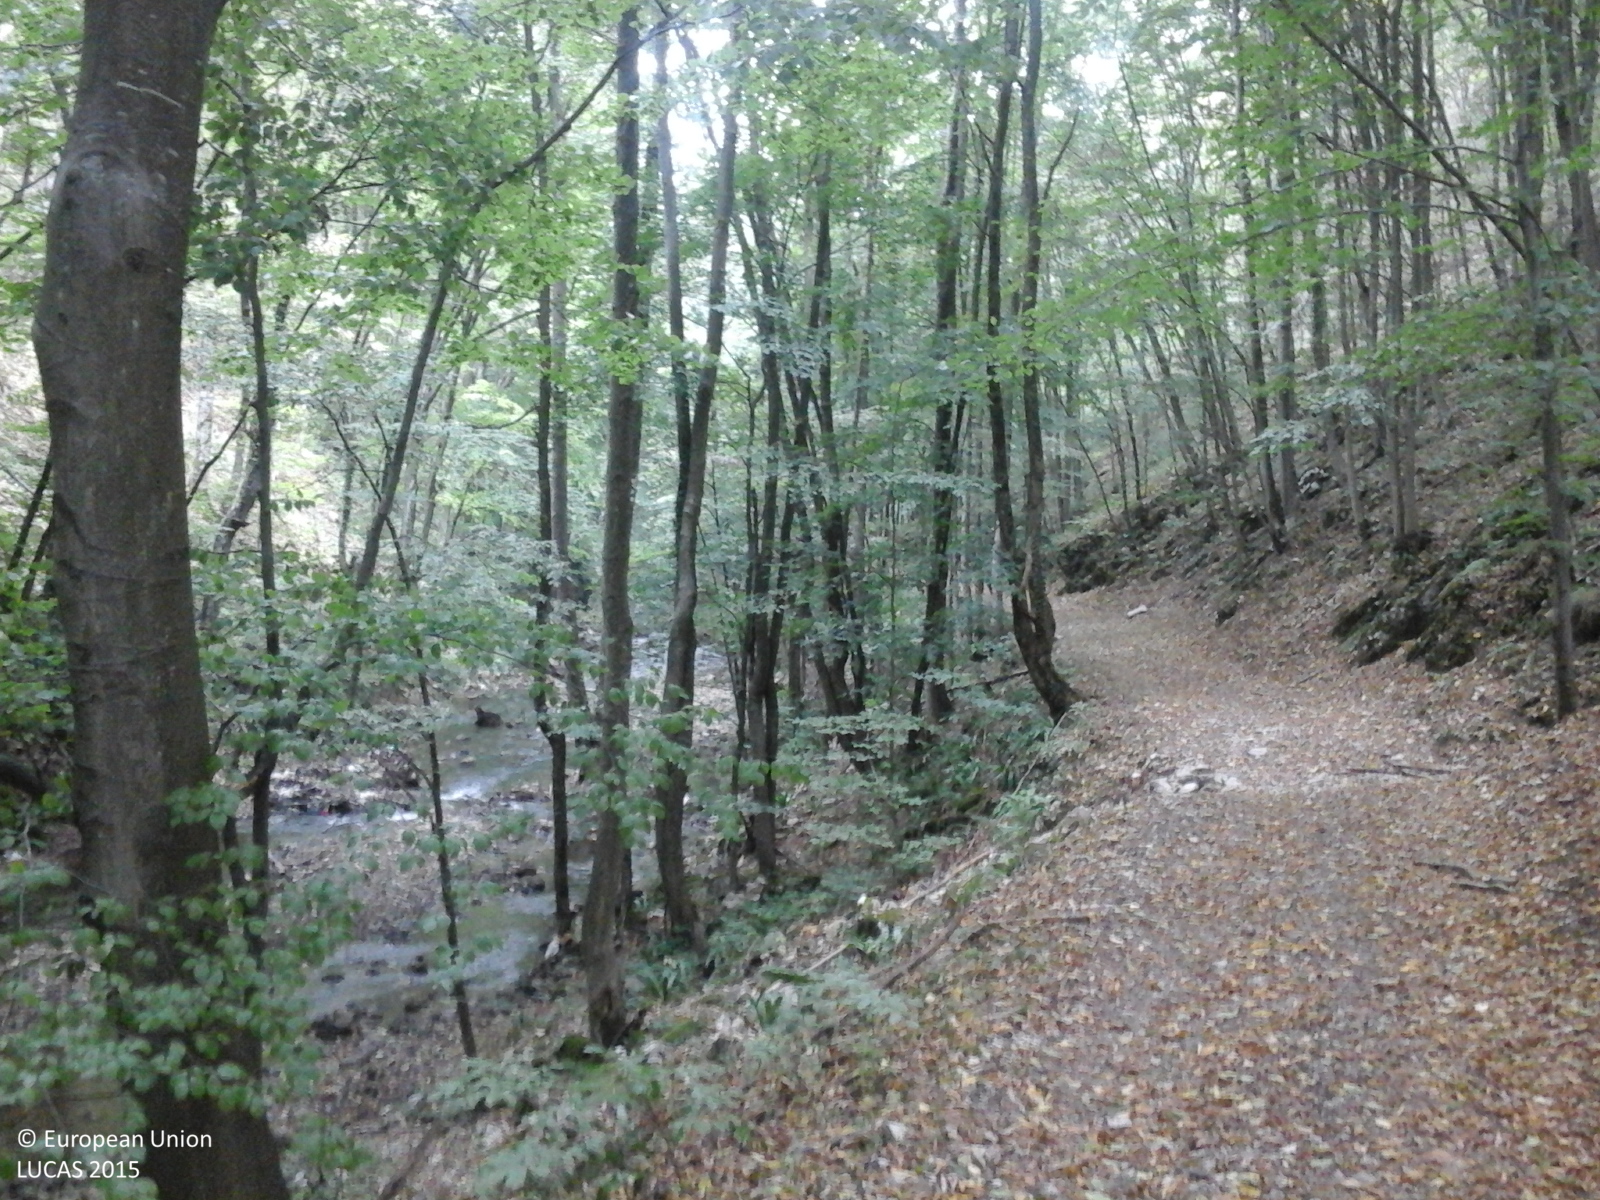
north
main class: Woodland
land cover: Broadleaved woodland
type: beech forest
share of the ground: > 75 %
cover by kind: broadleaved forest trees 100 %
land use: Forestry
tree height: > 5 m
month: August
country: RO
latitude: 45.1262
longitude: 21.8453
